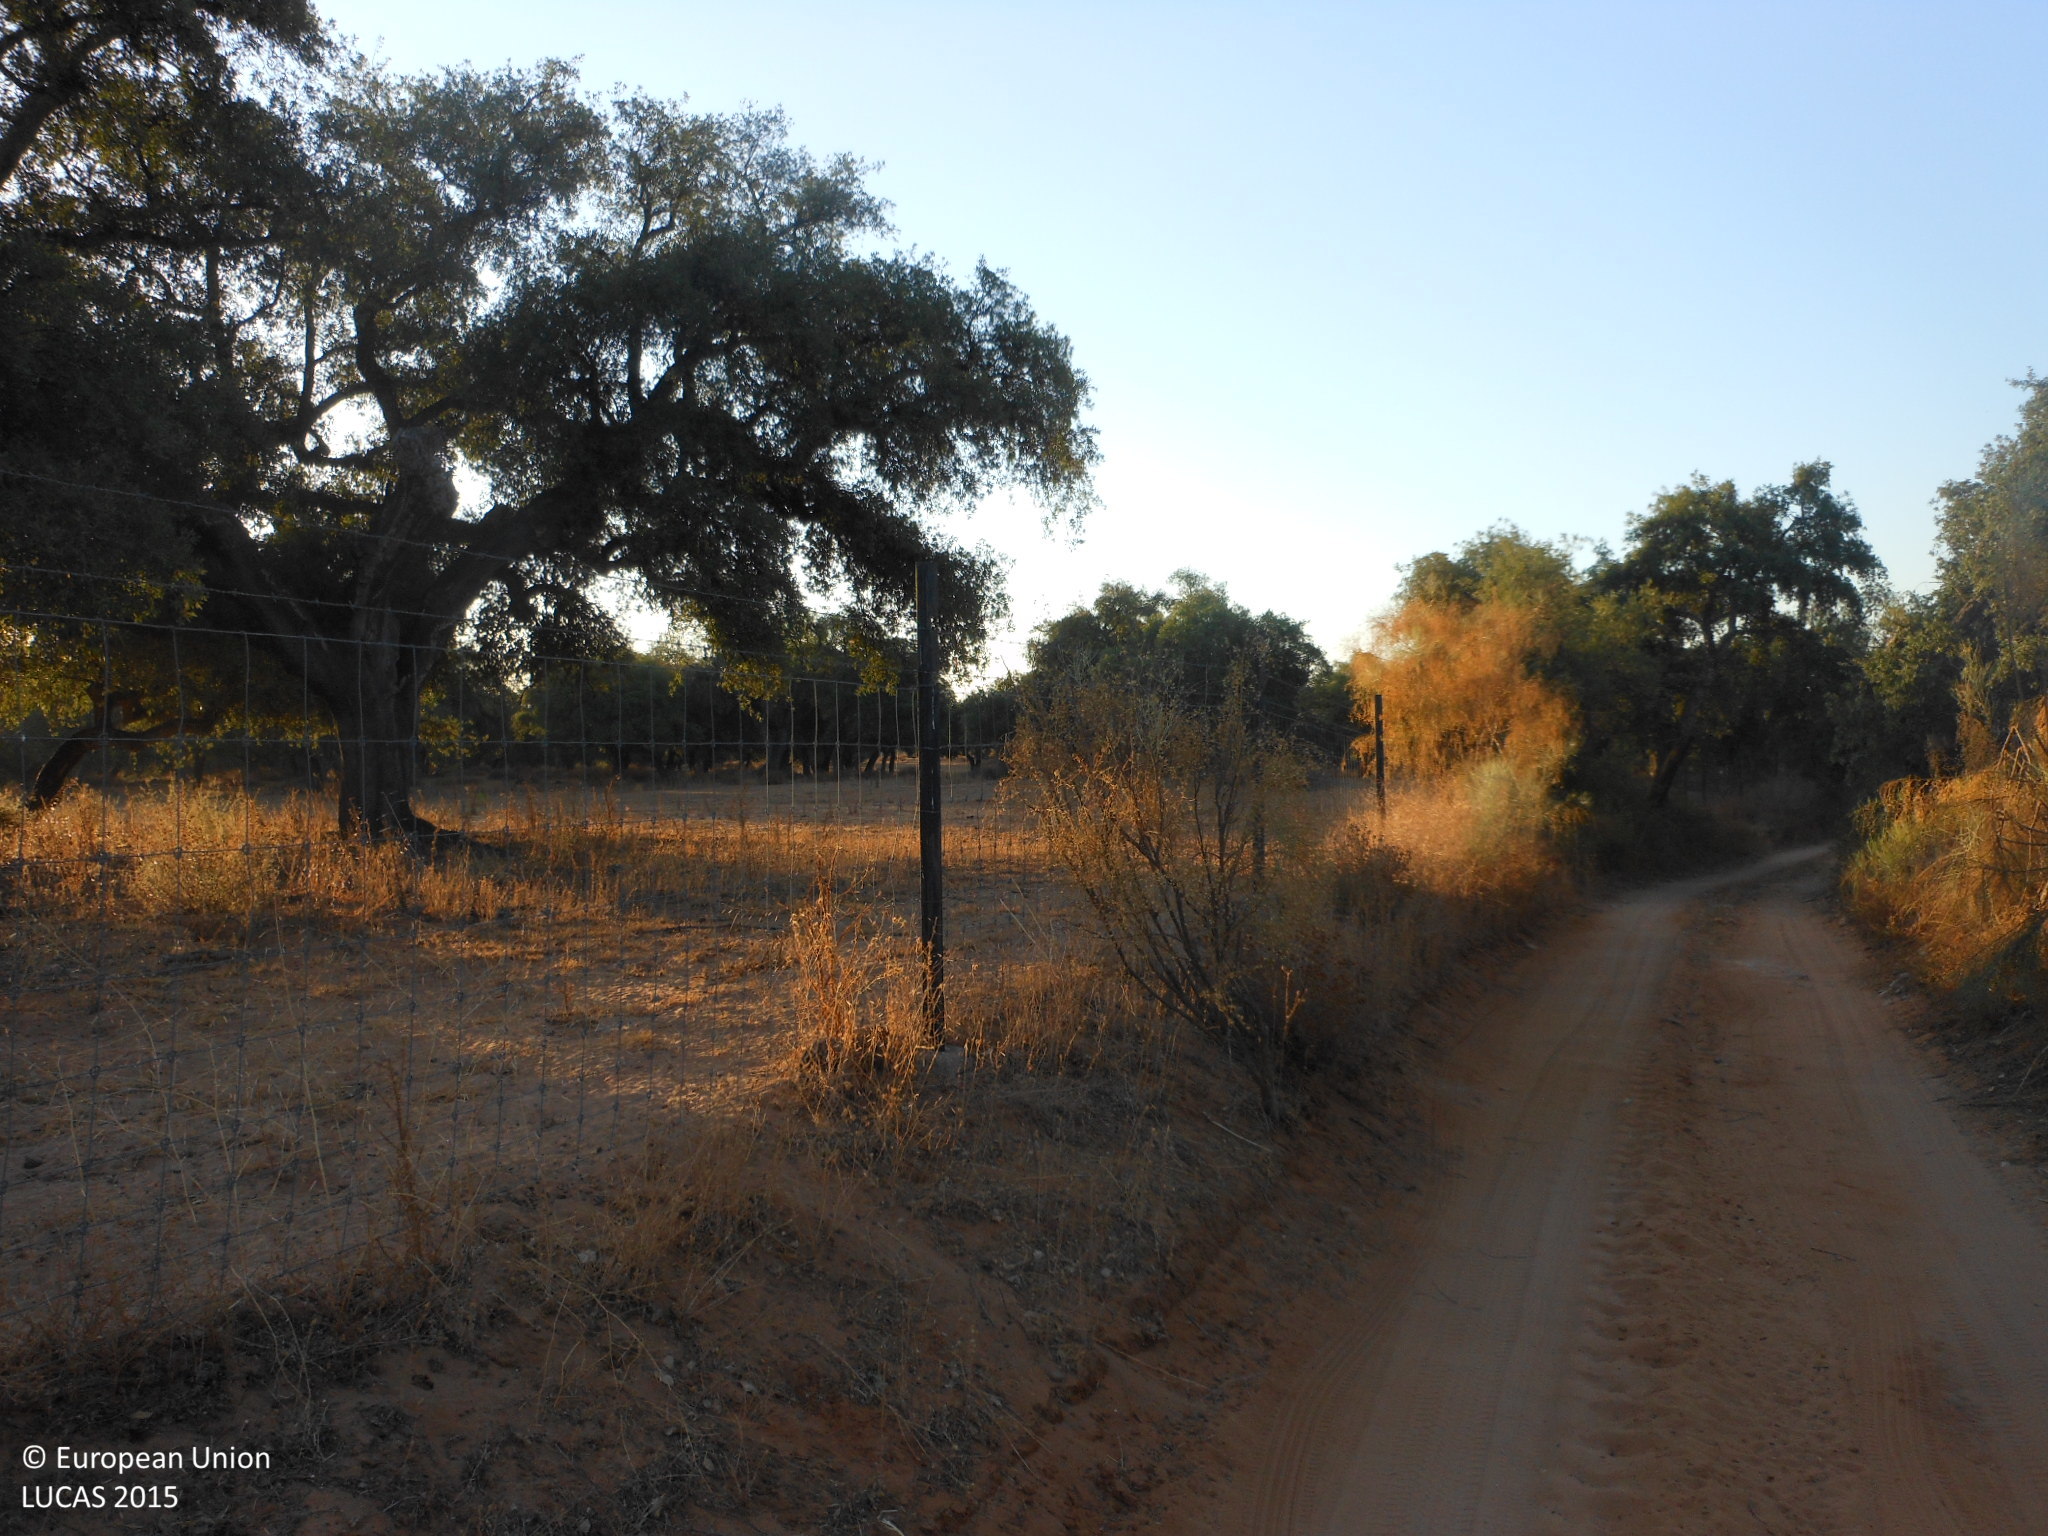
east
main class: Woodland
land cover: Broadleaved woodland
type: broadleaved evergreen forest
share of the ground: 50 - 75 %
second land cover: Shrubland without tree cover
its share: 10 - 25 %
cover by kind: broadleaved forest trees 60 %, unconsolidated bare surface 20 %, shrubs 15 %, herbaceous plants 5 %
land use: Forestry
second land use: Agriculture (excluding fallow land and kitchen gardens)
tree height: > 5 m
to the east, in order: Broadleaved woodland; Shrubland without tree cover; Tracks; Broadleaved woodland
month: July
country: ES
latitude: 37.2649
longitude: -5.4730
